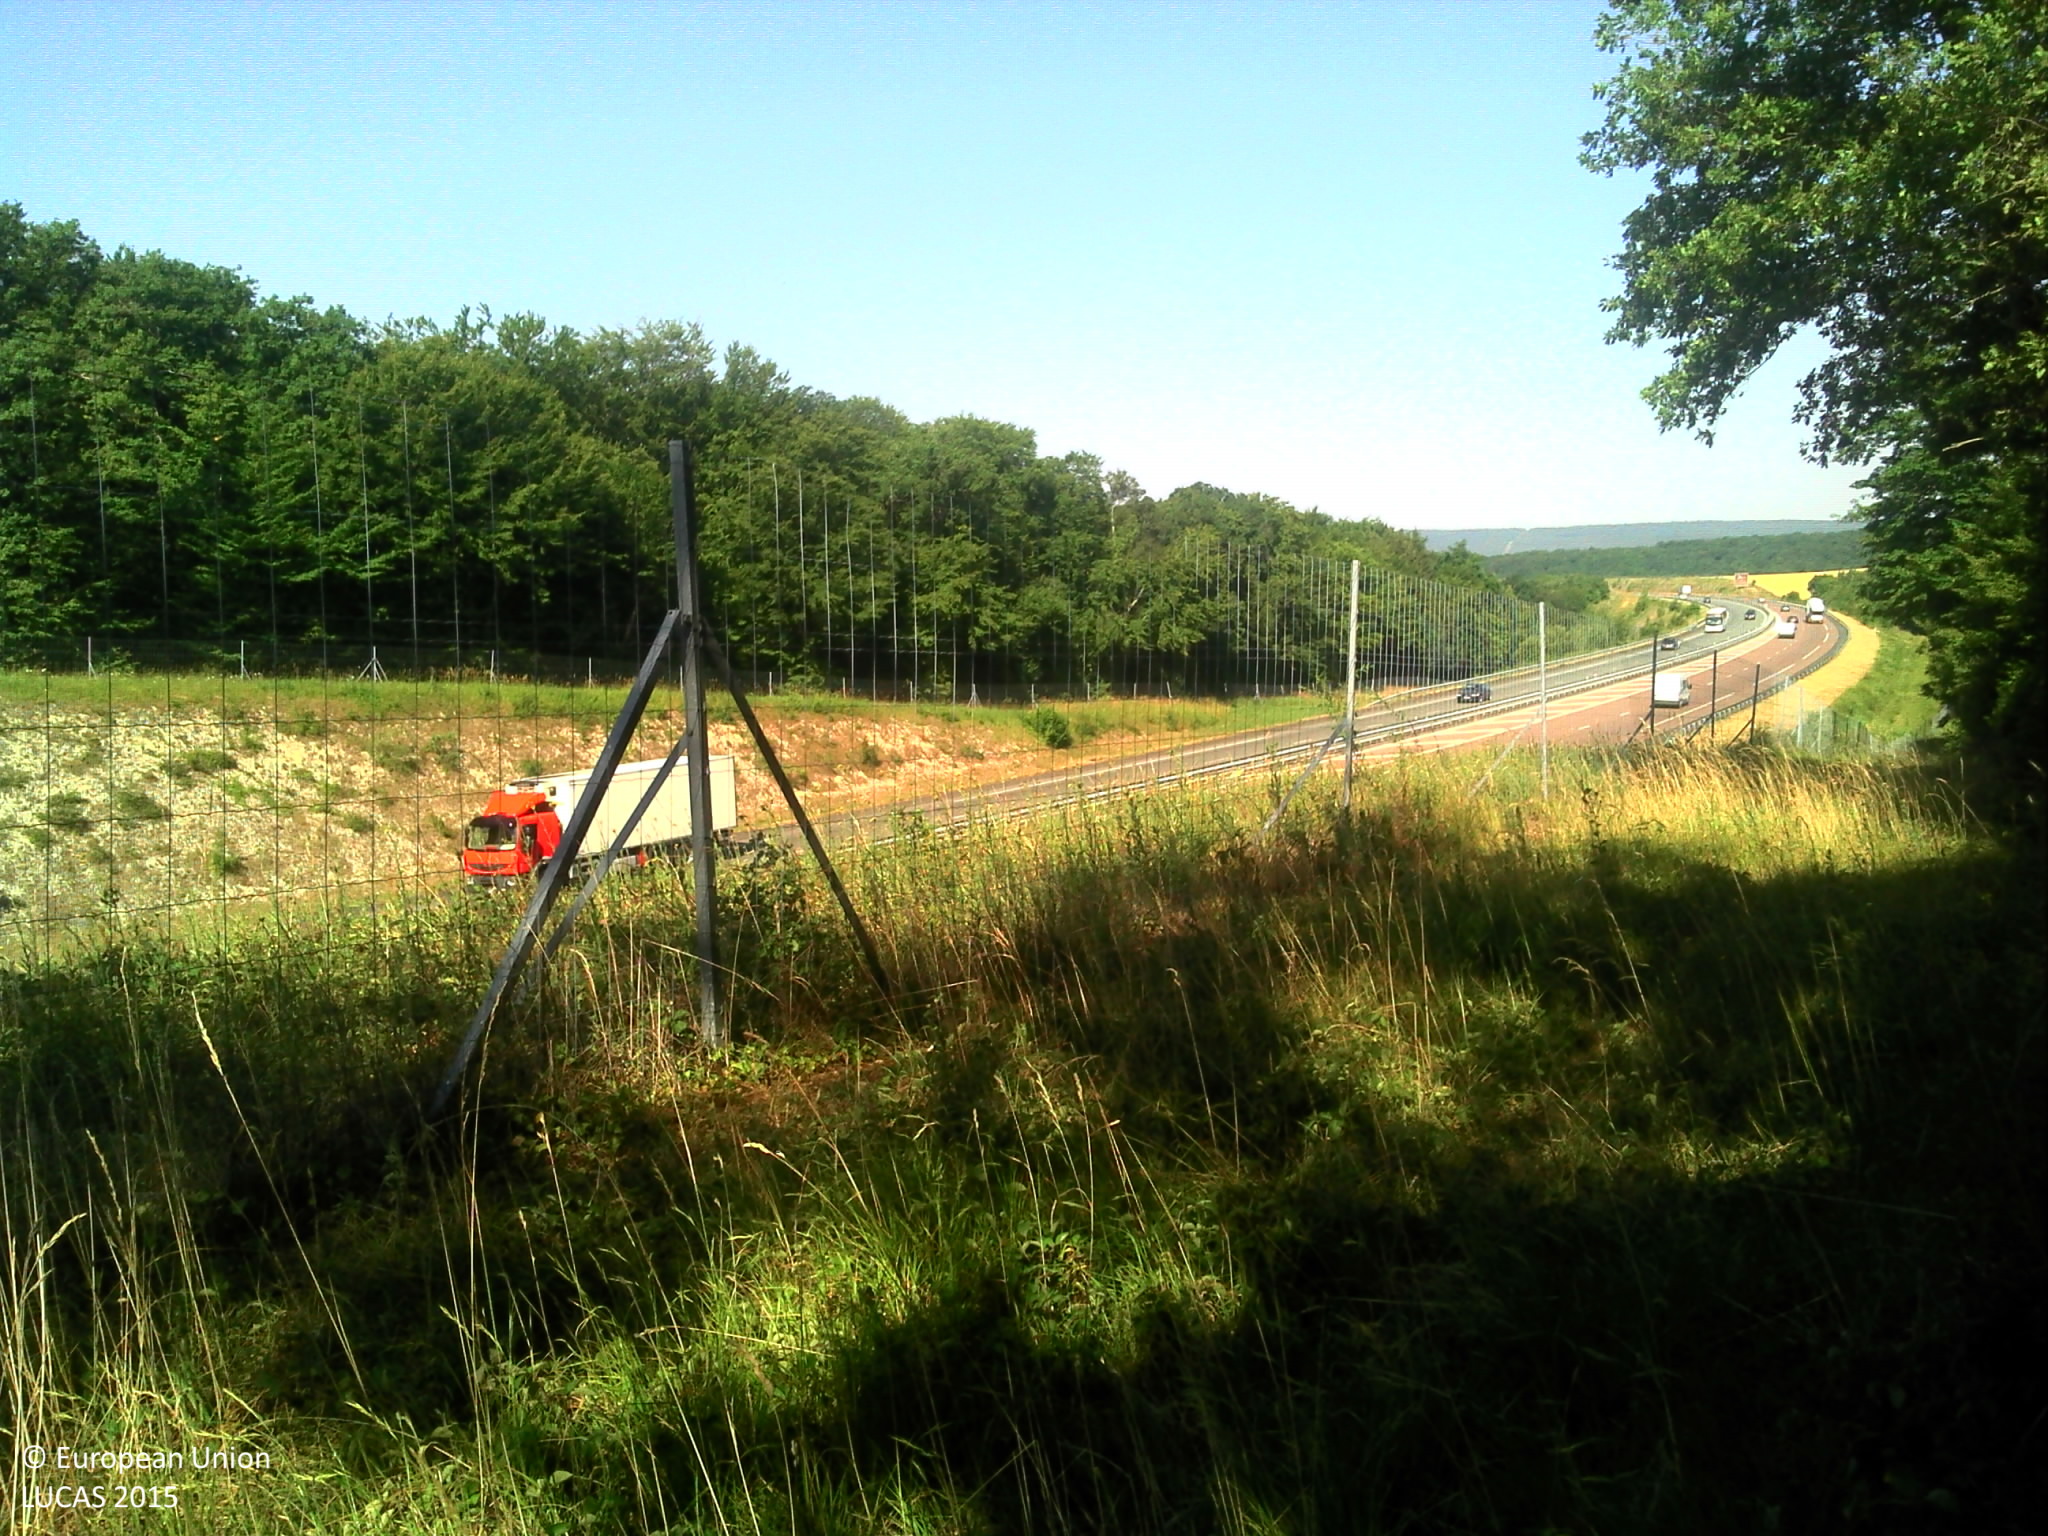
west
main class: Woodland
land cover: Broadleaved woodland
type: mesophytic deciduous forest
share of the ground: > 75 %
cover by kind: broadleaved forest trees 80 %, herbaceous plants 15 %, lichens and mosses 5 %
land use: Forestry
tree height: > 5 m
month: July
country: FR
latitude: 48.0855
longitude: 4.8570
